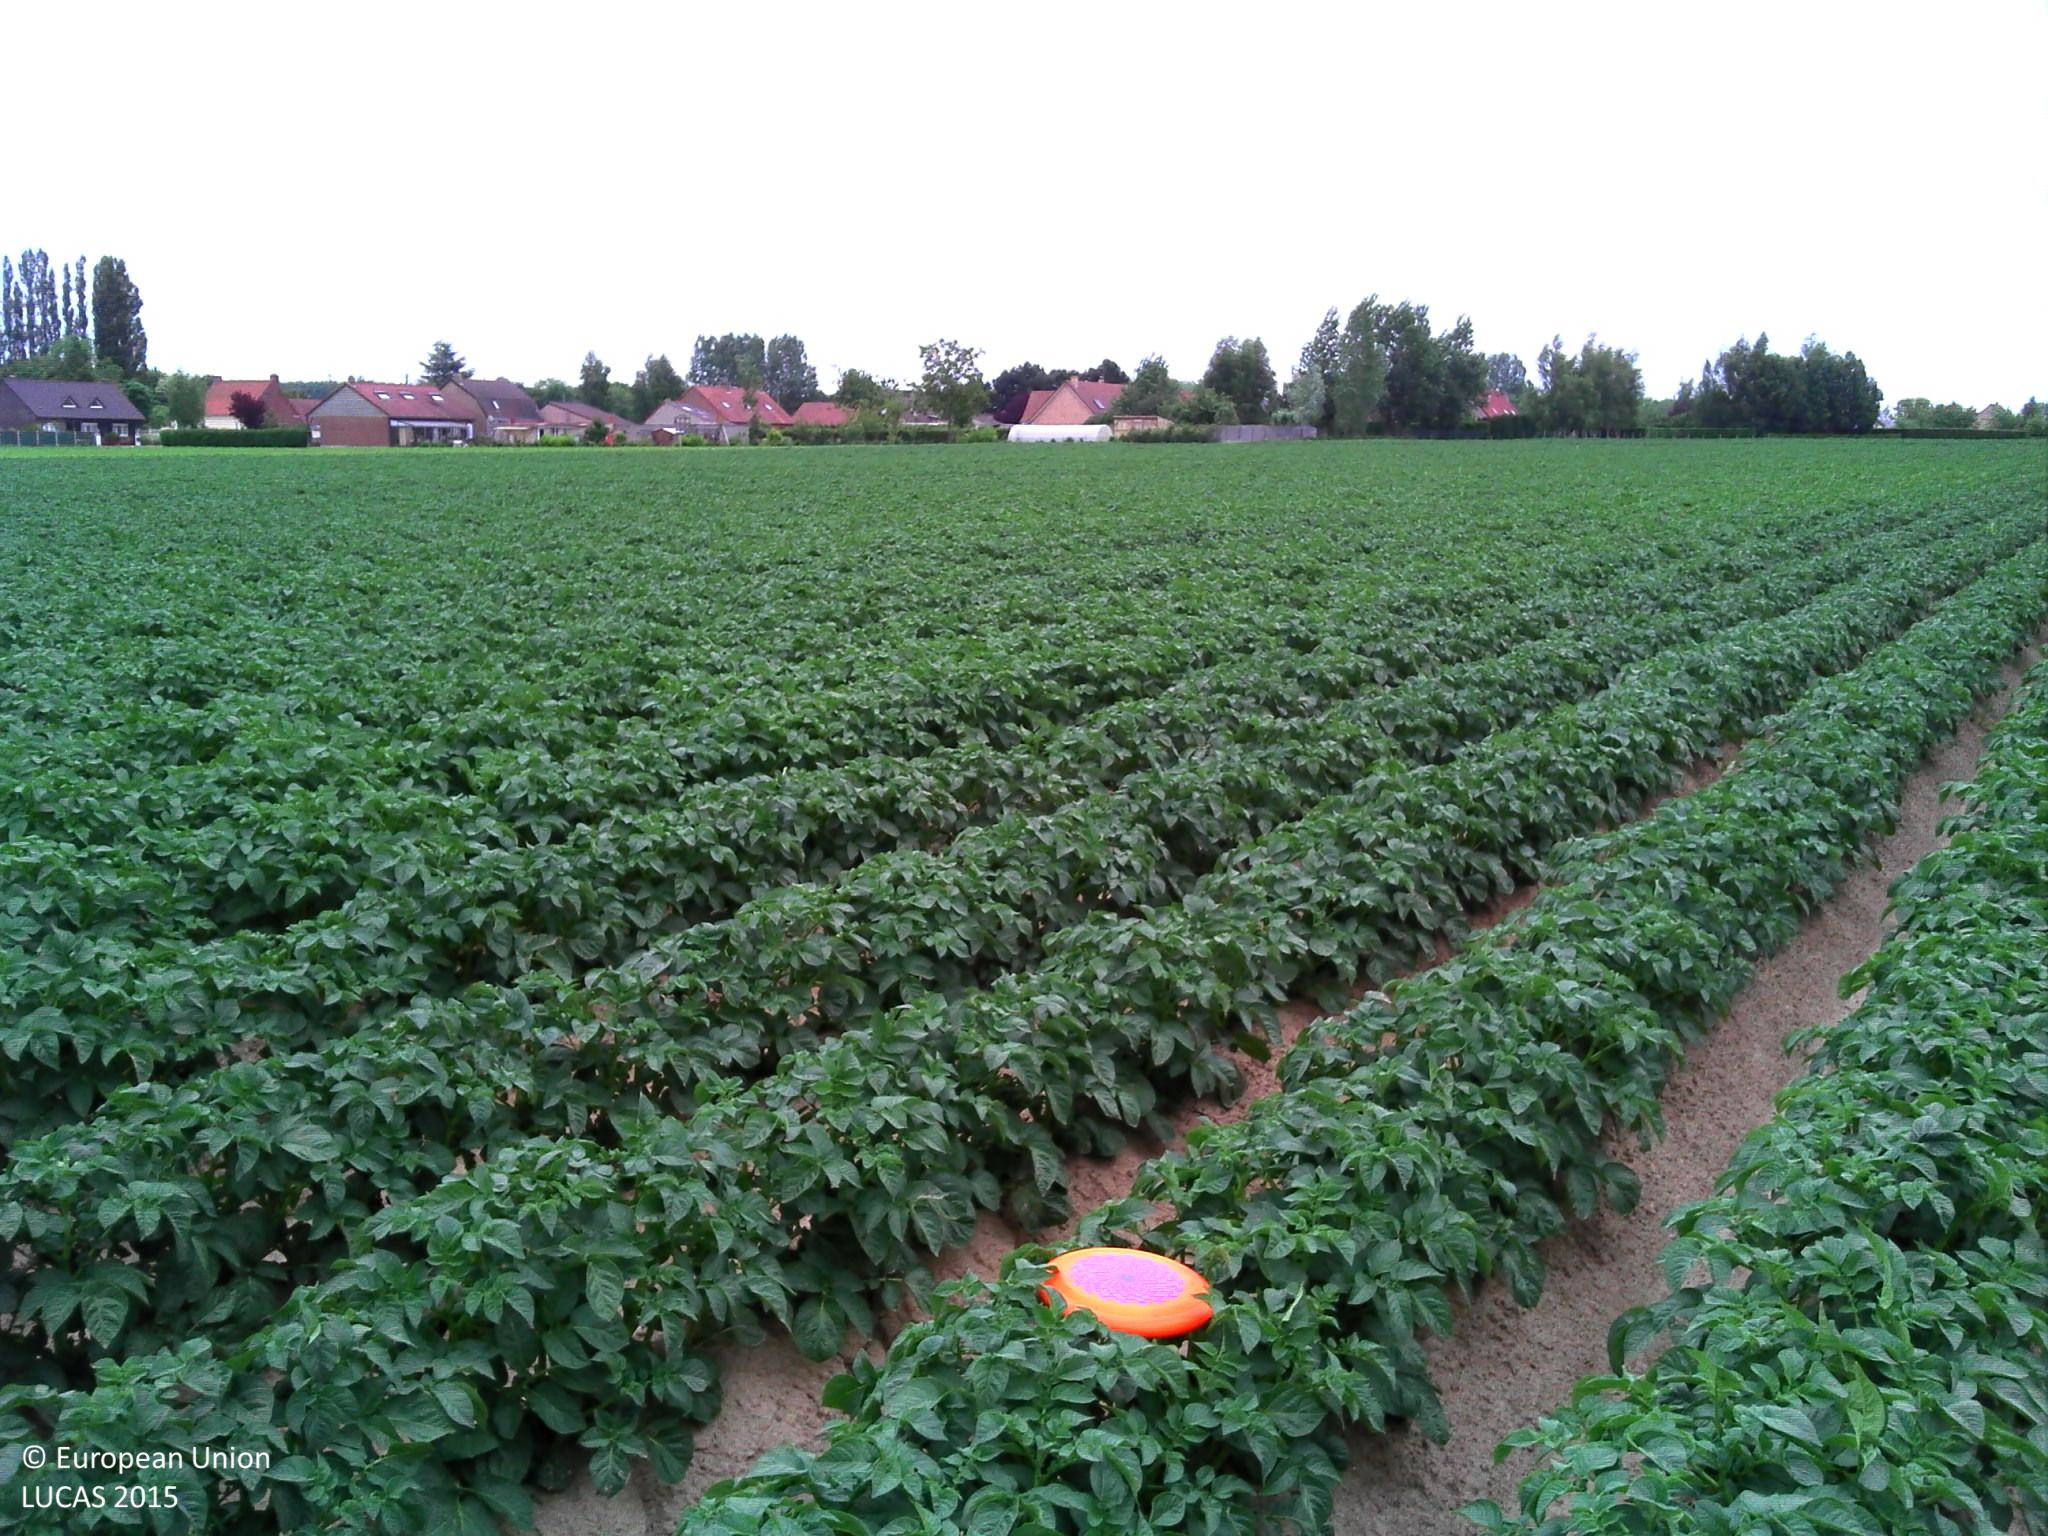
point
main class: Cropland
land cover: Potatoes
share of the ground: > 75 %
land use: Agriculture (excluding fallow land and kitchen gardens)
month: June
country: FR
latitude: 50.6843
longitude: 2.3292
